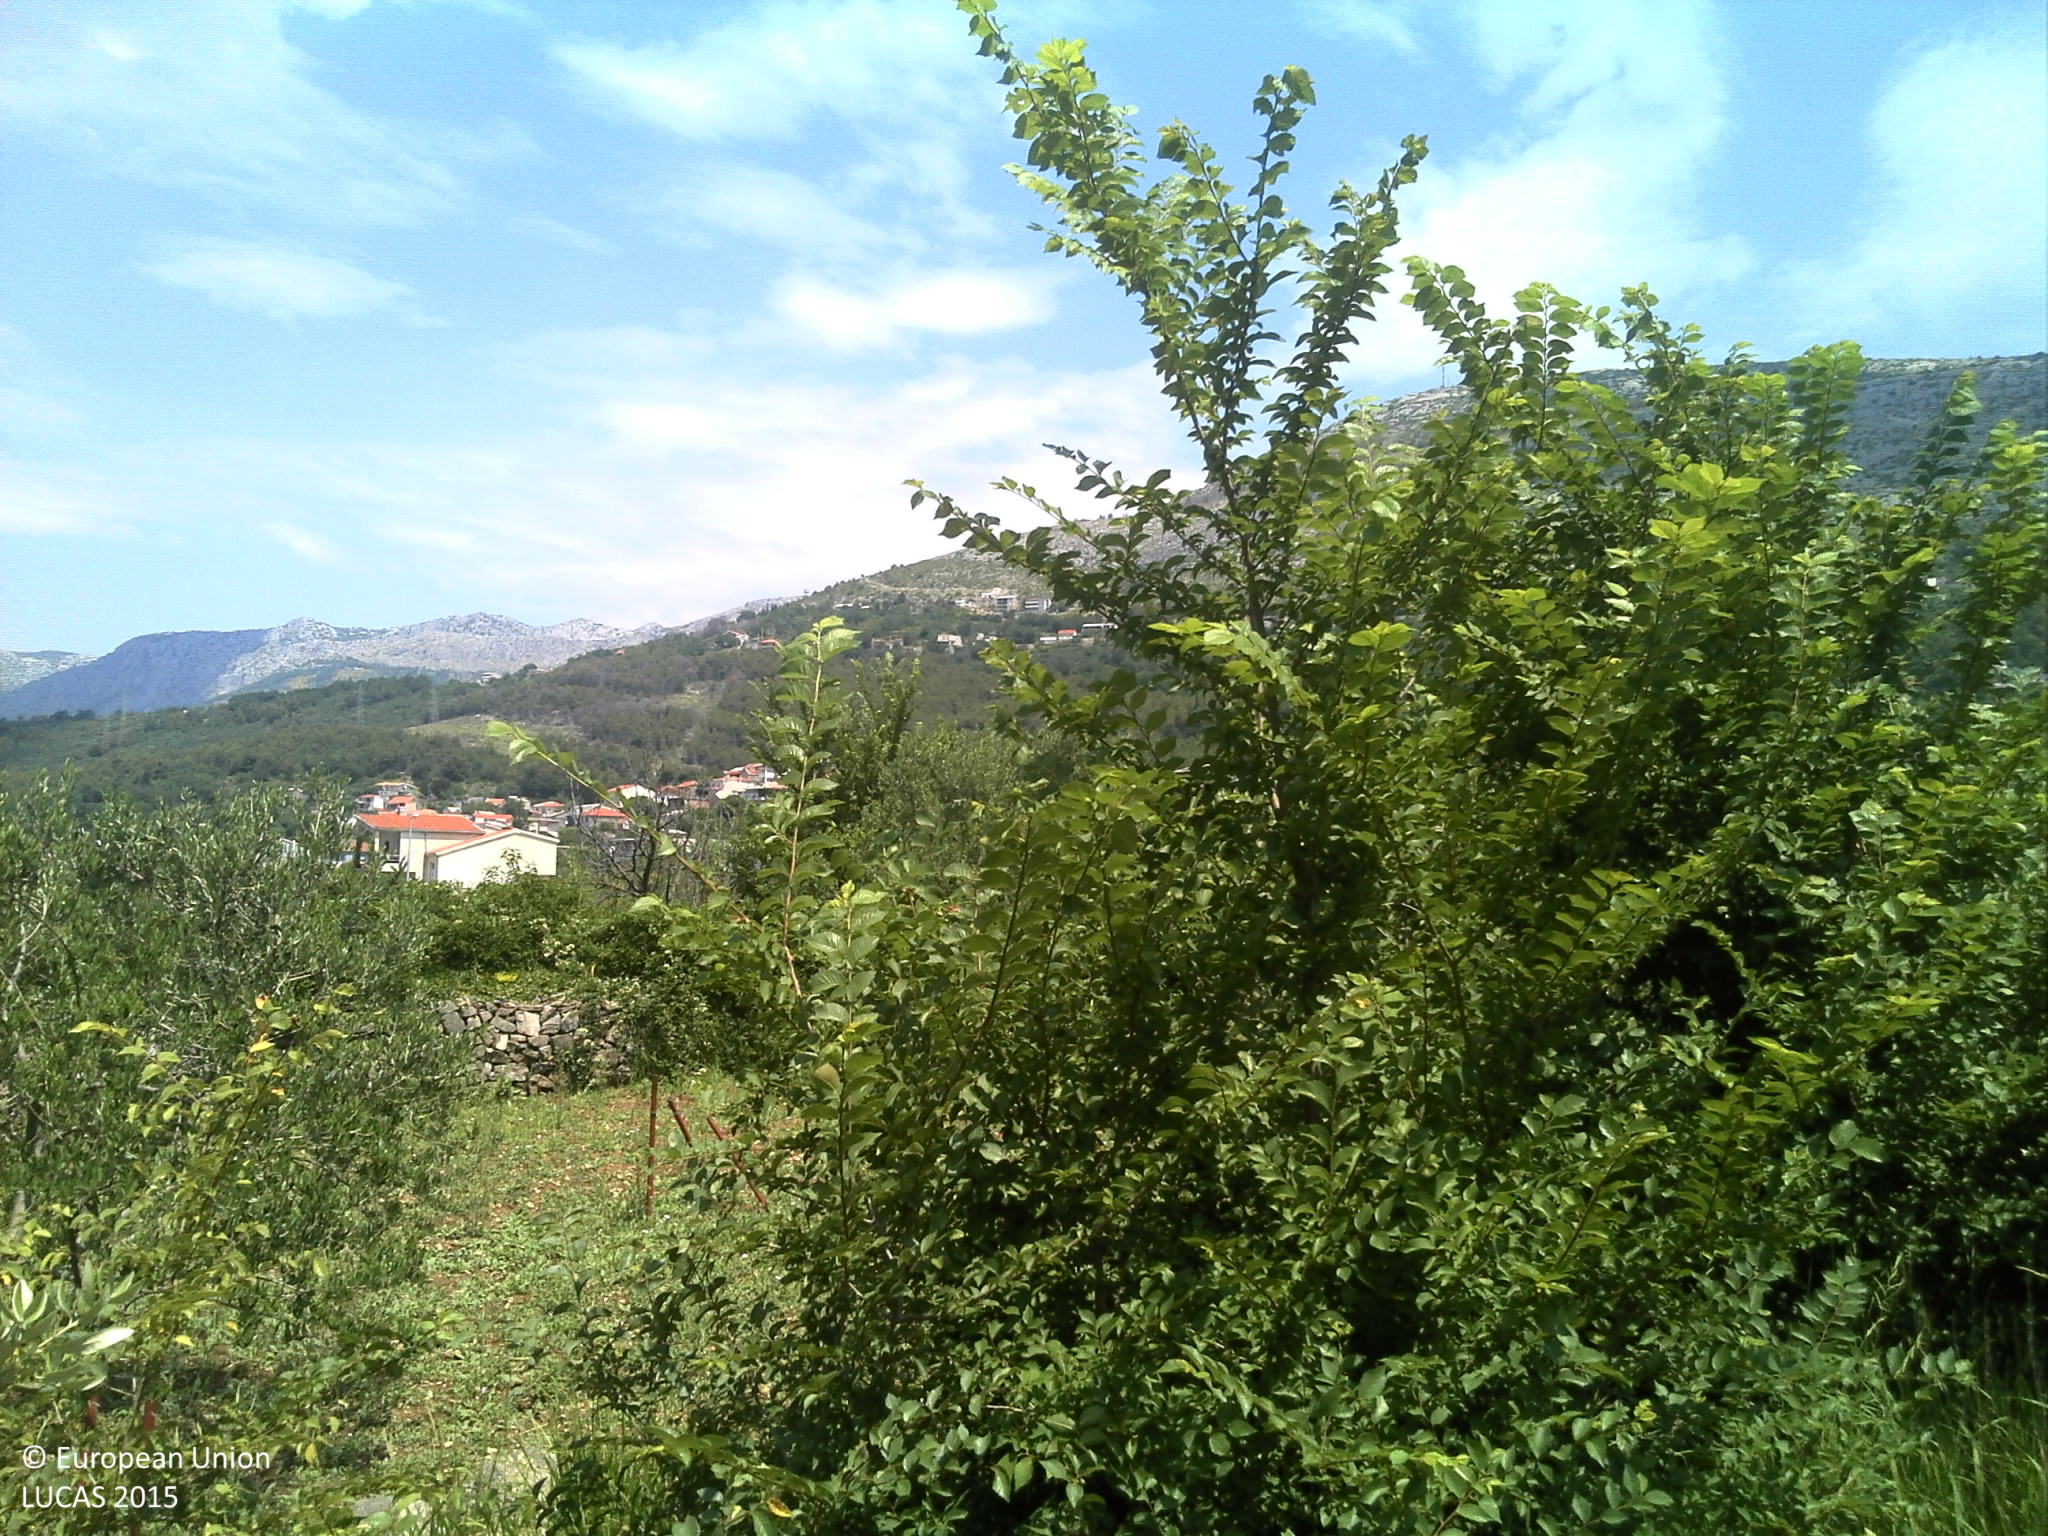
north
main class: Grassland
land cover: Grassland with sparse tree/shrub cover
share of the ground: > 75 %
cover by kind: herbaceous plants 85 %, shrubs 10 %, broadleaved forest trees 5 %
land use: Agriculture (excluding fallow land and kitchen gardens)
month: June
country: HR
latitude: 43.4885
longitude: 16.6063
